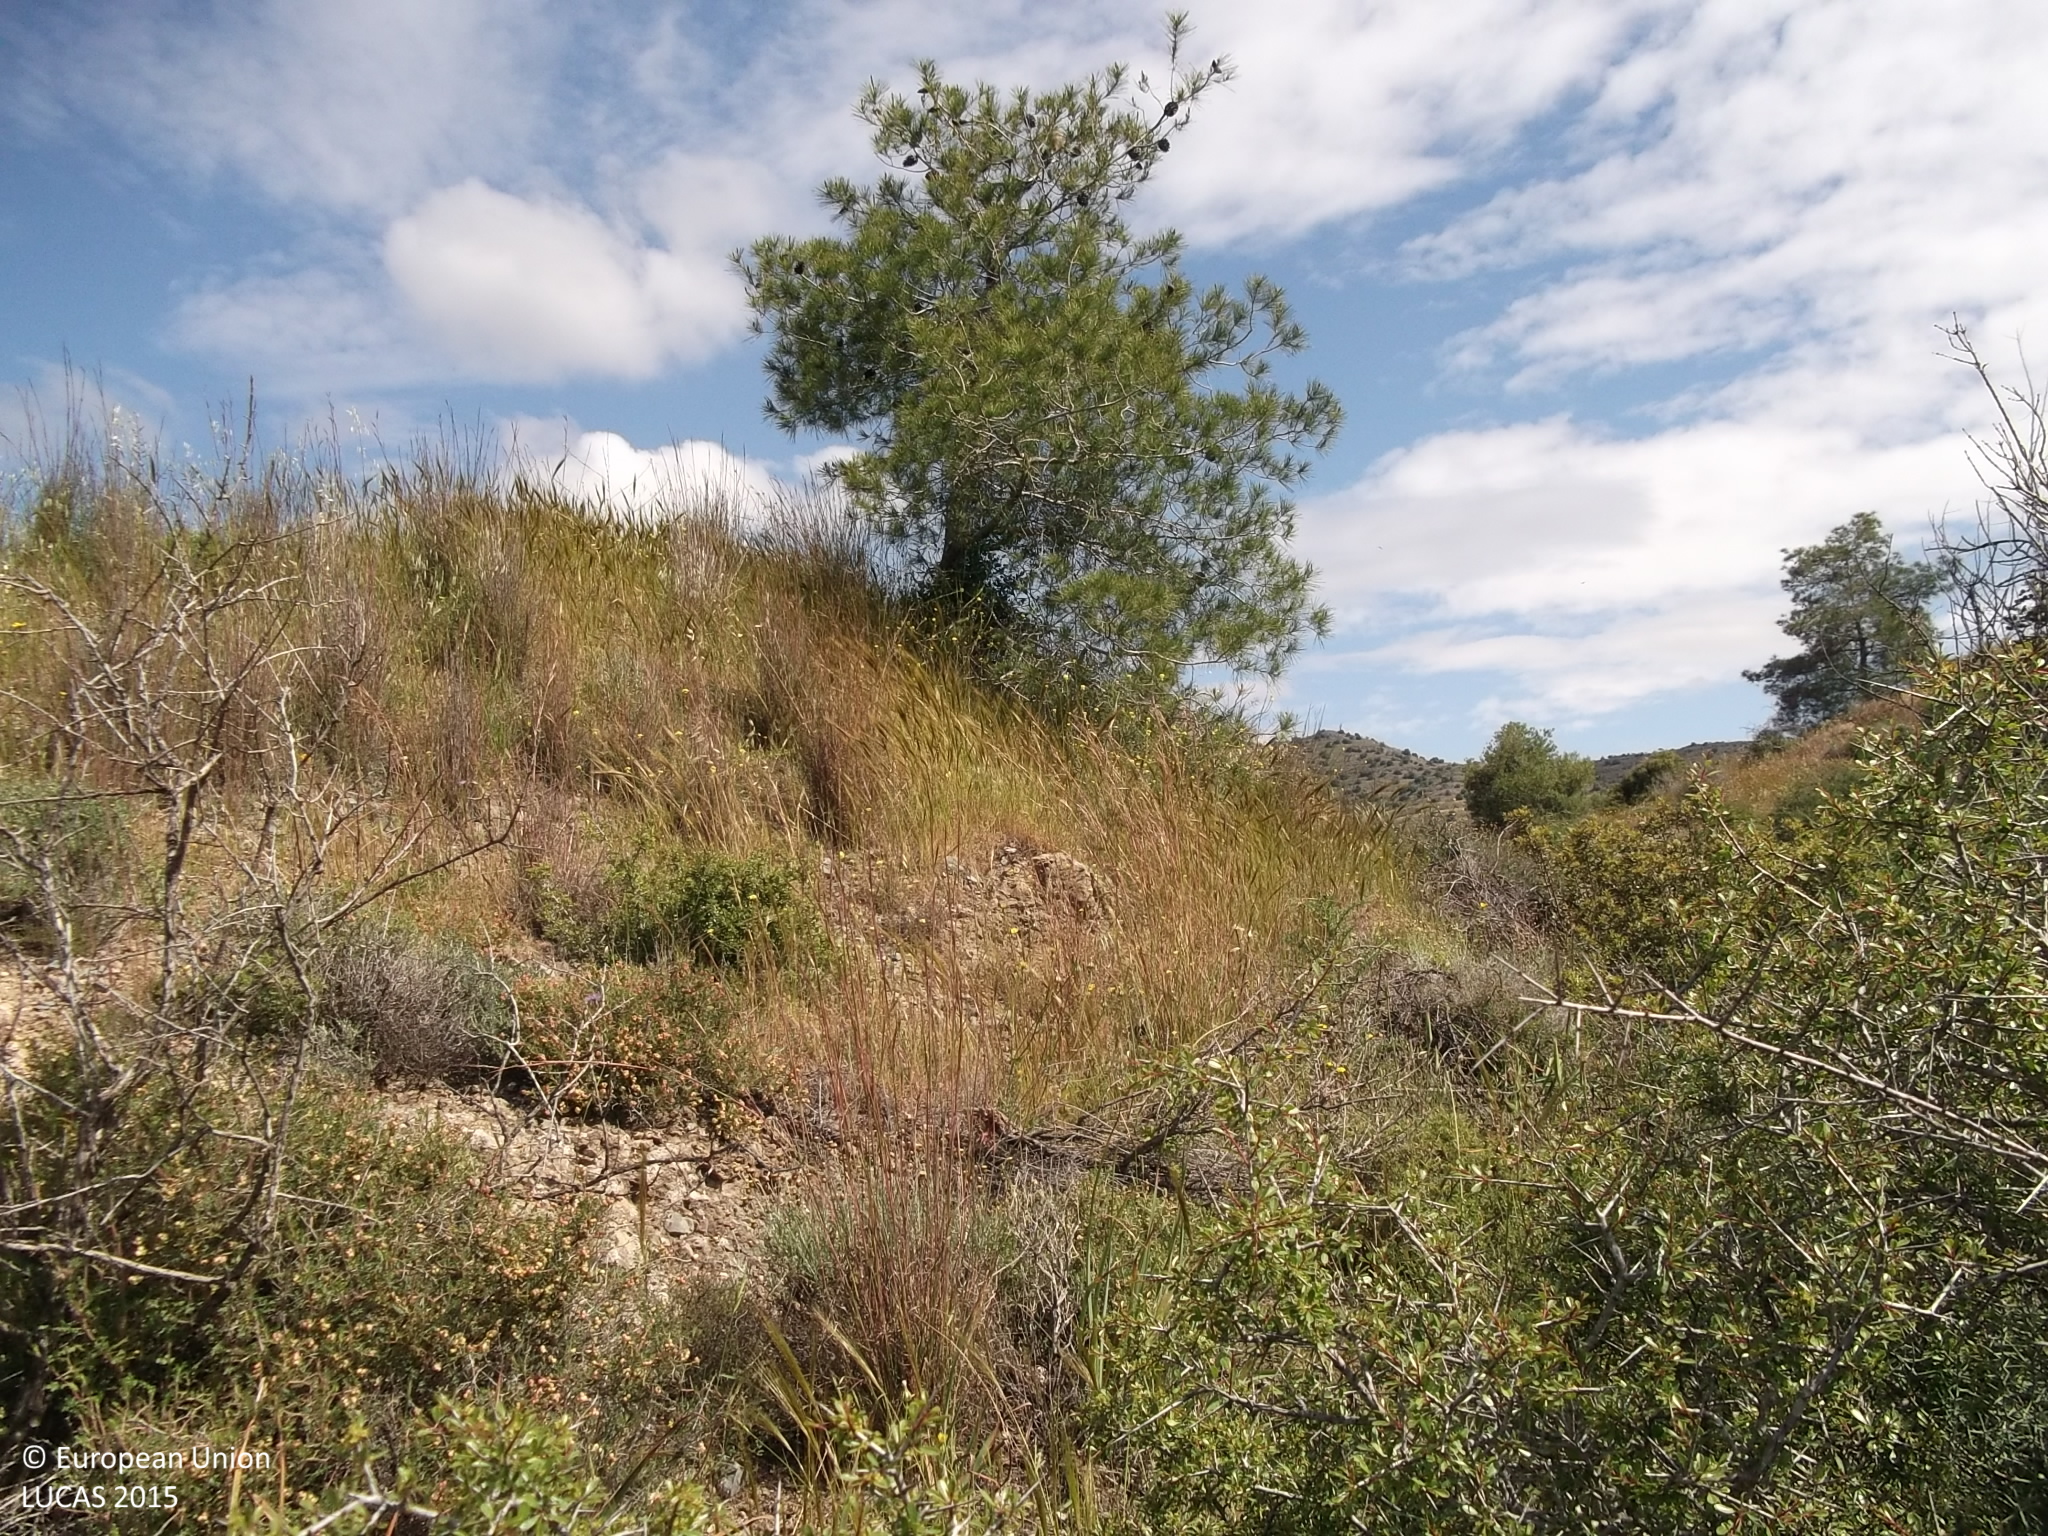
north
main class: Shrubland
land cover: Shrubland with sparse tree cover
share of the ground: 50 - 75 %
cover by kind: shrubs 50 %, herbaceous plants 25 %, consolidated bare surface 10 %, unconsolidated bare surface 10 %, coniferous forest trees 5 %
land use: Semi-natural and natural areas not in use
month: April
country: CY
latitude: 34.8525
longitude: 33.4274
